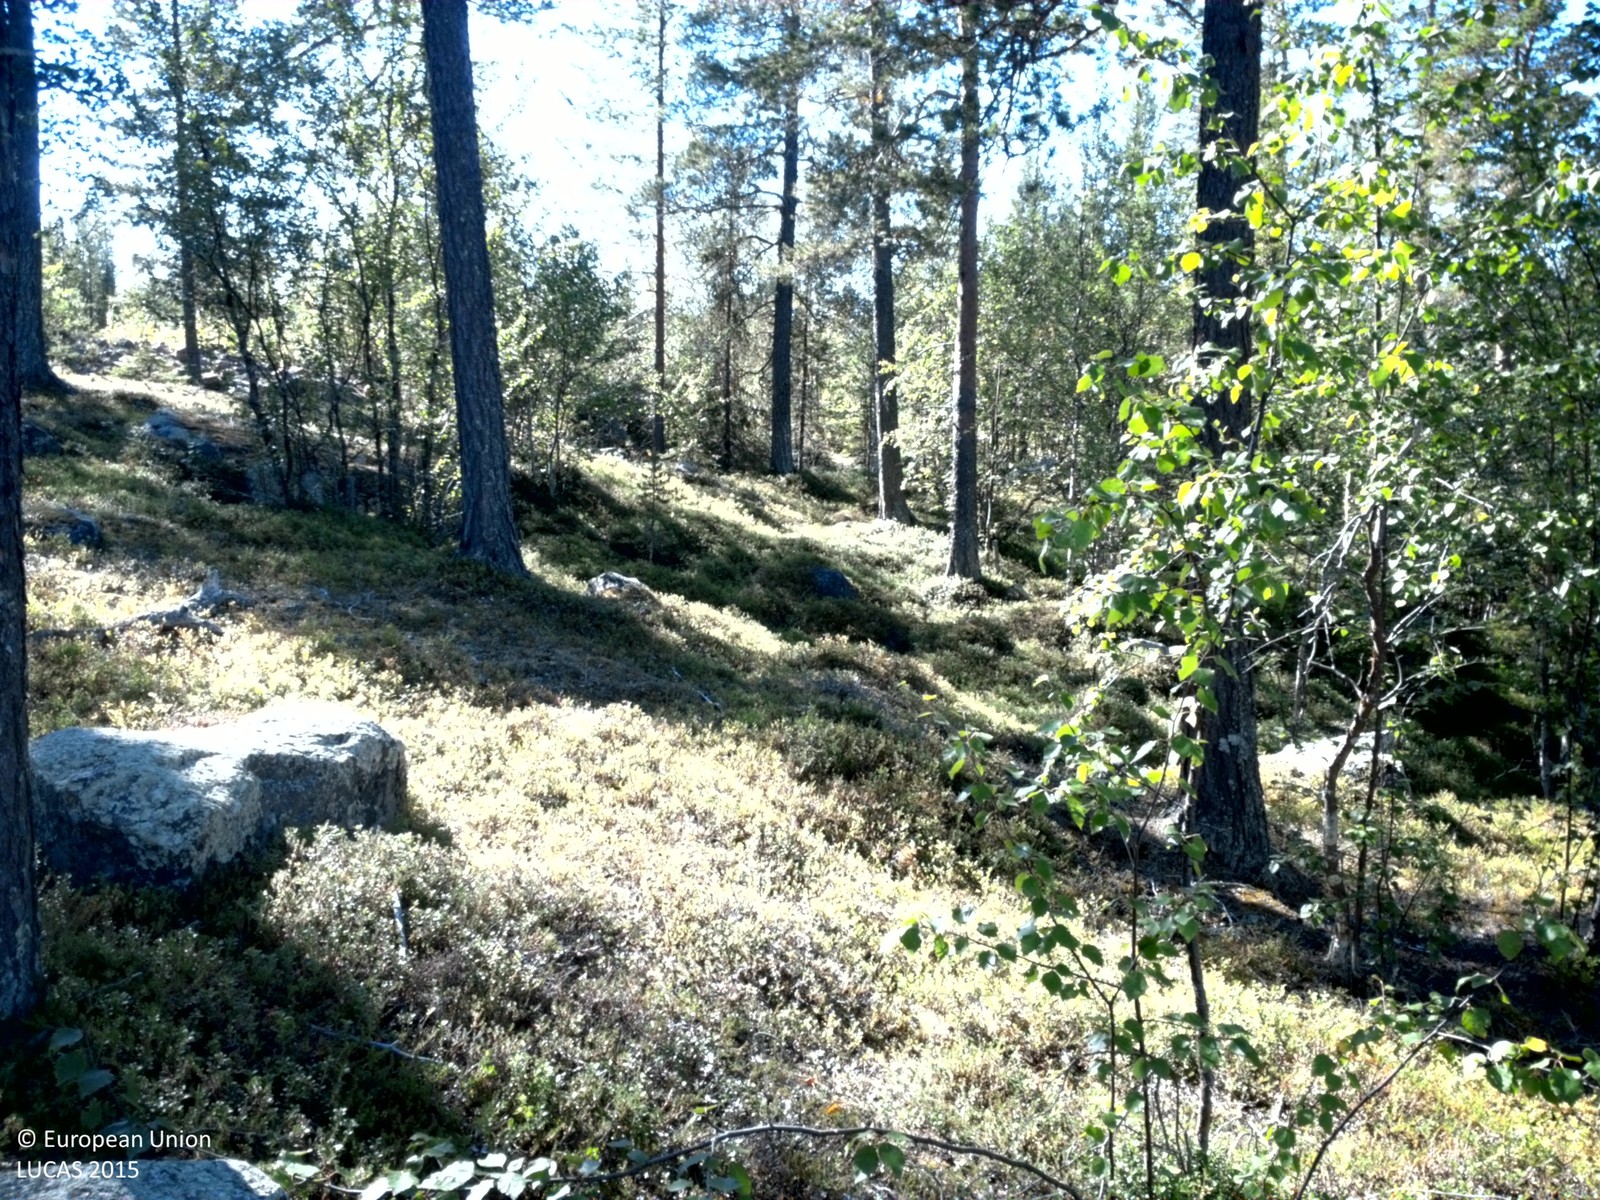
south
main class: Woodland
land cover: Pine dominated coniferous woodland
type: boreal forest
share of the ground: 25 - 50 %
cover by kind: shrubs 65 %, coniferous forest trees 25 %, broadleaved forest trees 5 %, consolidated bare surface 5 %
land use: Forestry
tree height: > 5 m
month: August
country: SE
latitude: 66.6333
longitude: 18.7393
